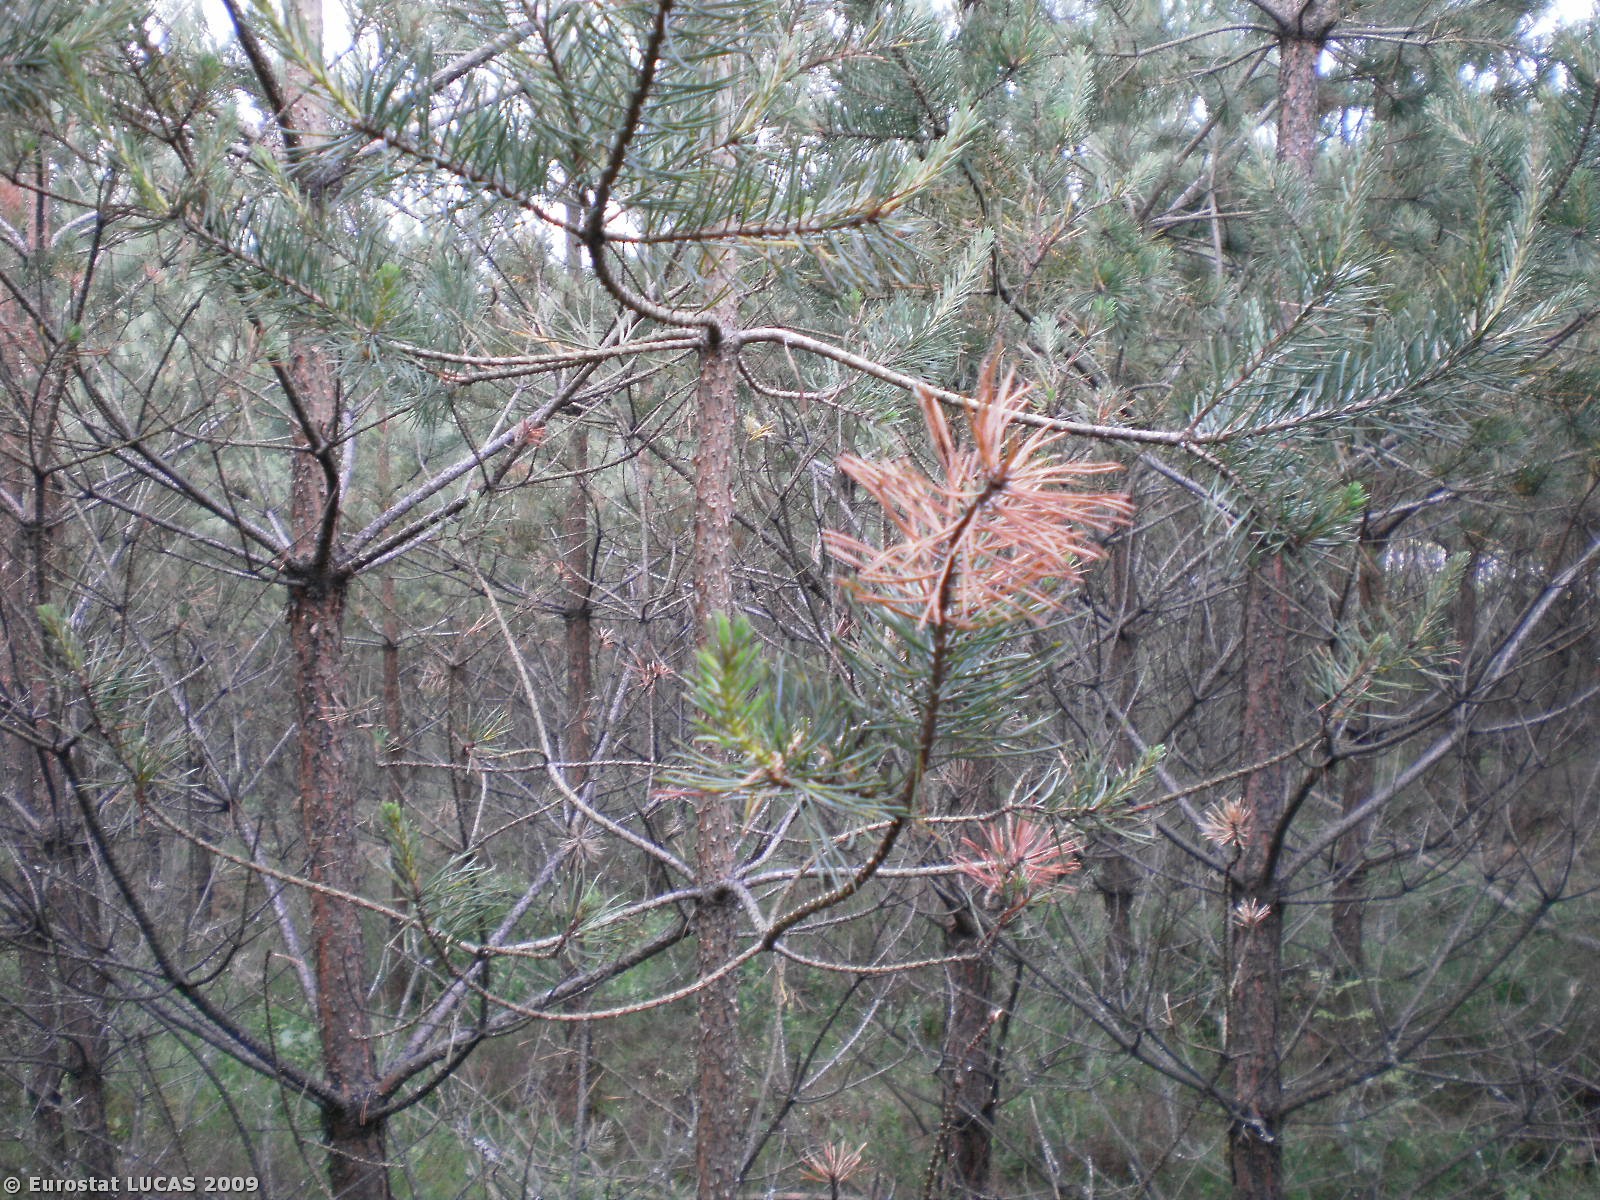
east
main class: Woodland
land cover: Coniferous woodland
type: hemiboreal forest and nemoral coniferous forest and mixed broadleaved-coniferous forest
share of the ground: > 75 %
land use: Forestry
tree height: > 5 m
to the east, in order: Coniferous woodland; Grassland with sparse tree/shrub cover
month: July
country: PL
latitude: 54.2326
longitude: 17.8215
